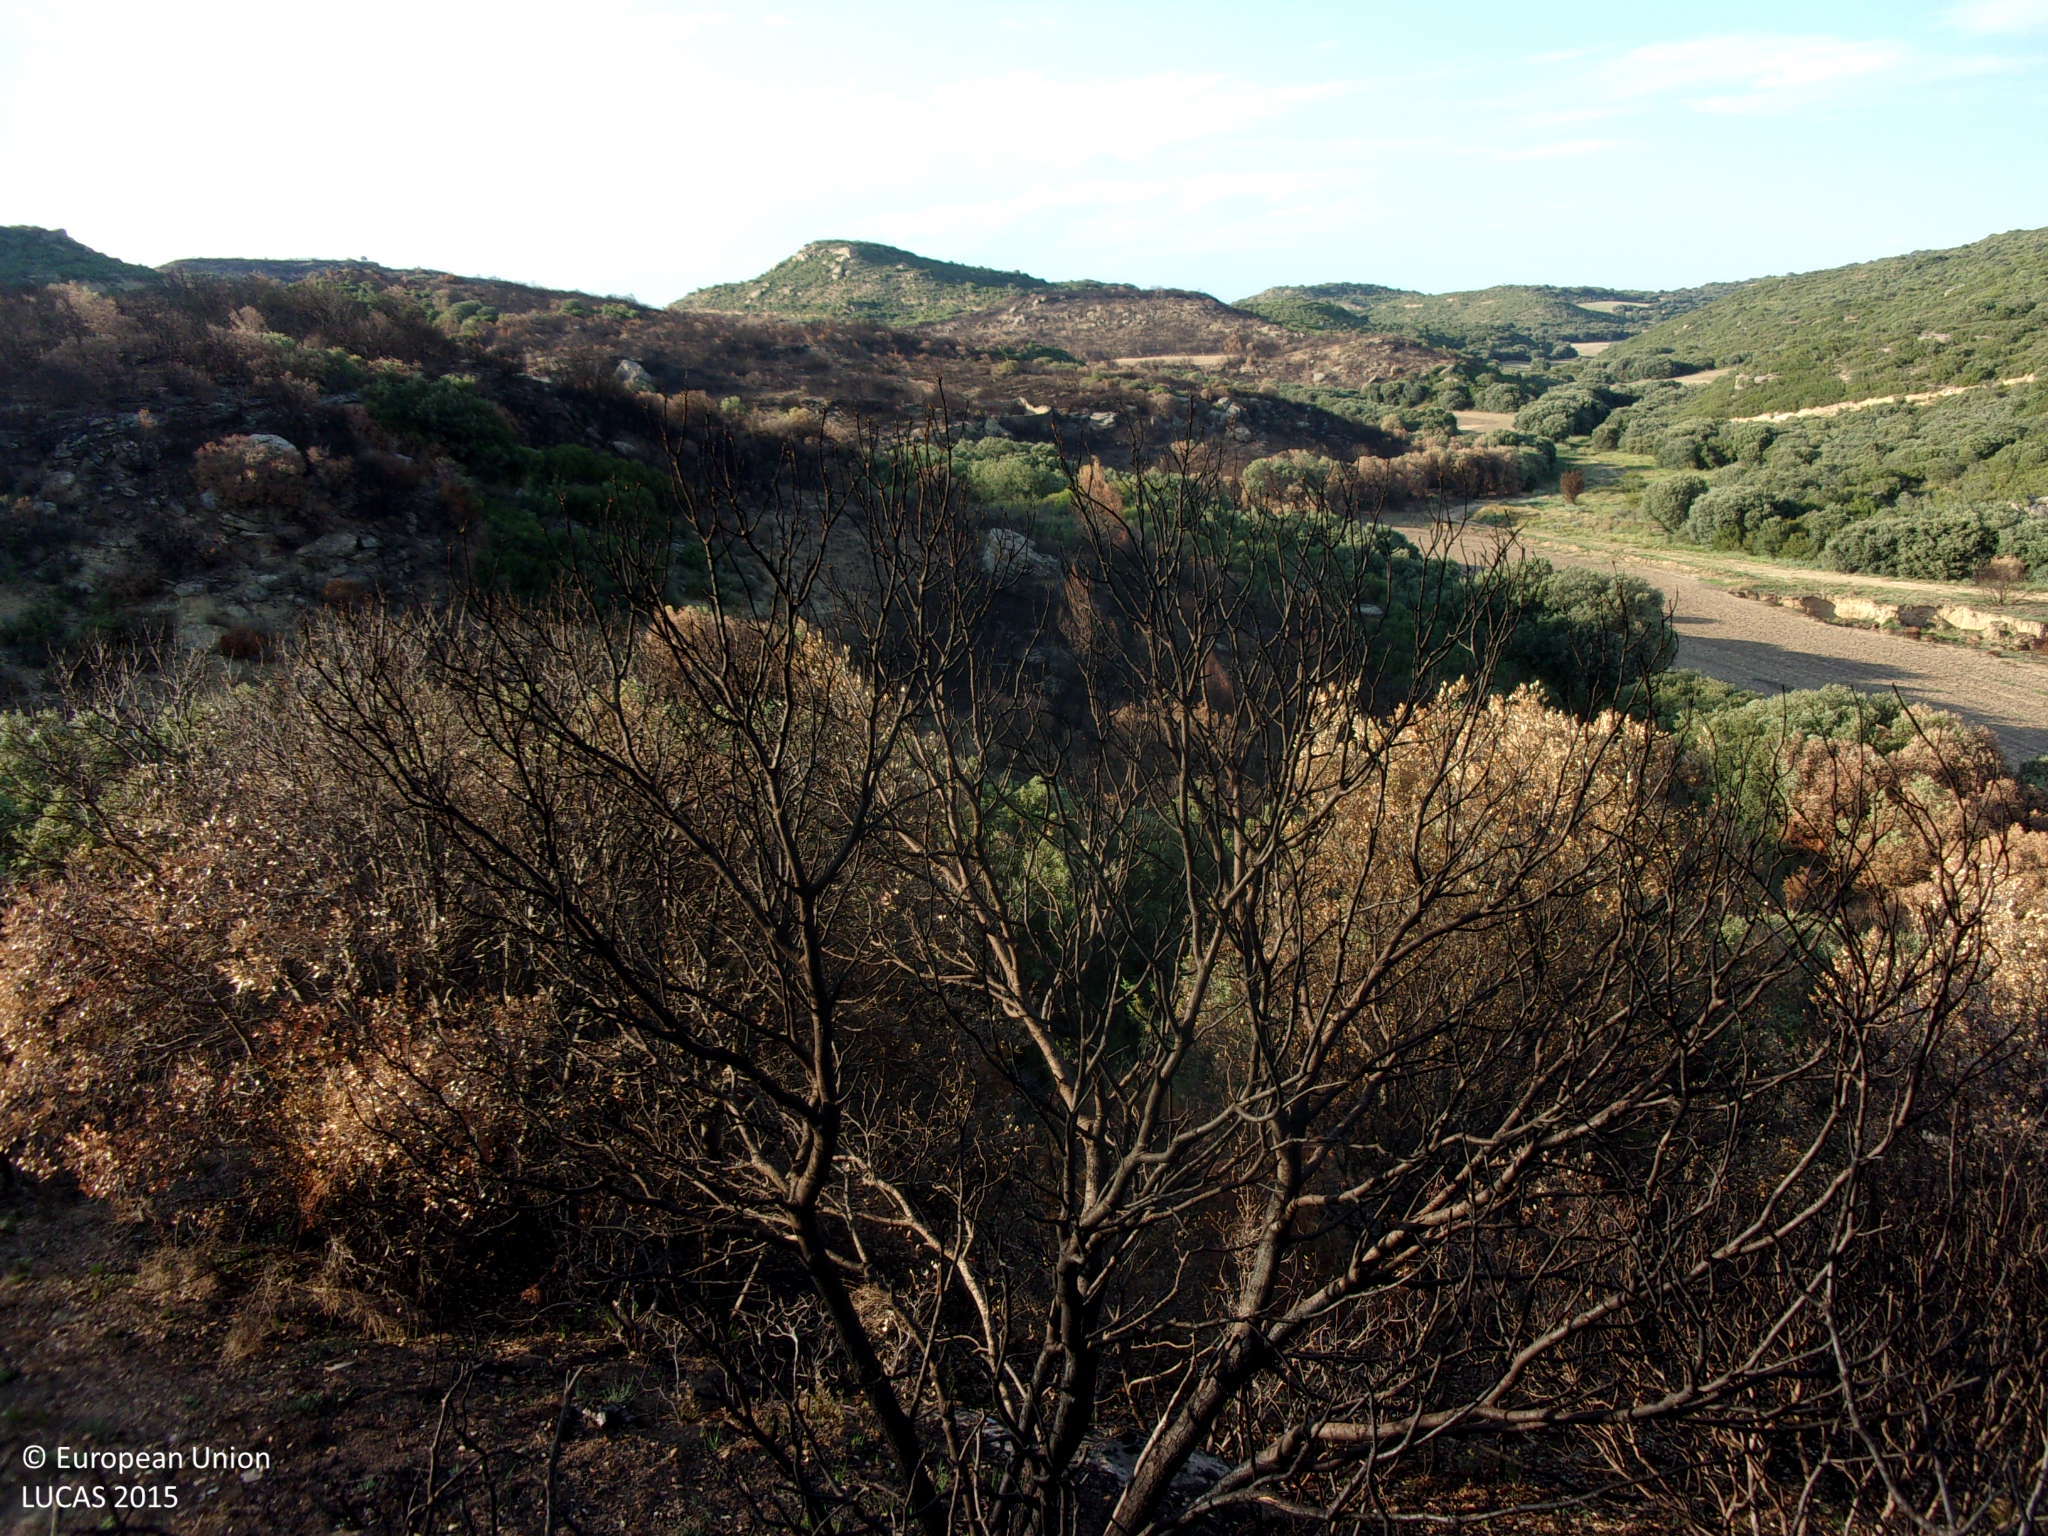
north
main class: Woodland
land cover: Broadleaved woodland
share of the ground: 10 - 25 %
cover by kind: unconsolidated bare surface 90 %, broadleaved forest trees 10 %
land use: Forestry
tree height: < 5 m
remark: Burnt area
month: August
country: ES
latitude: 42.2966
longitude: -1.1034
